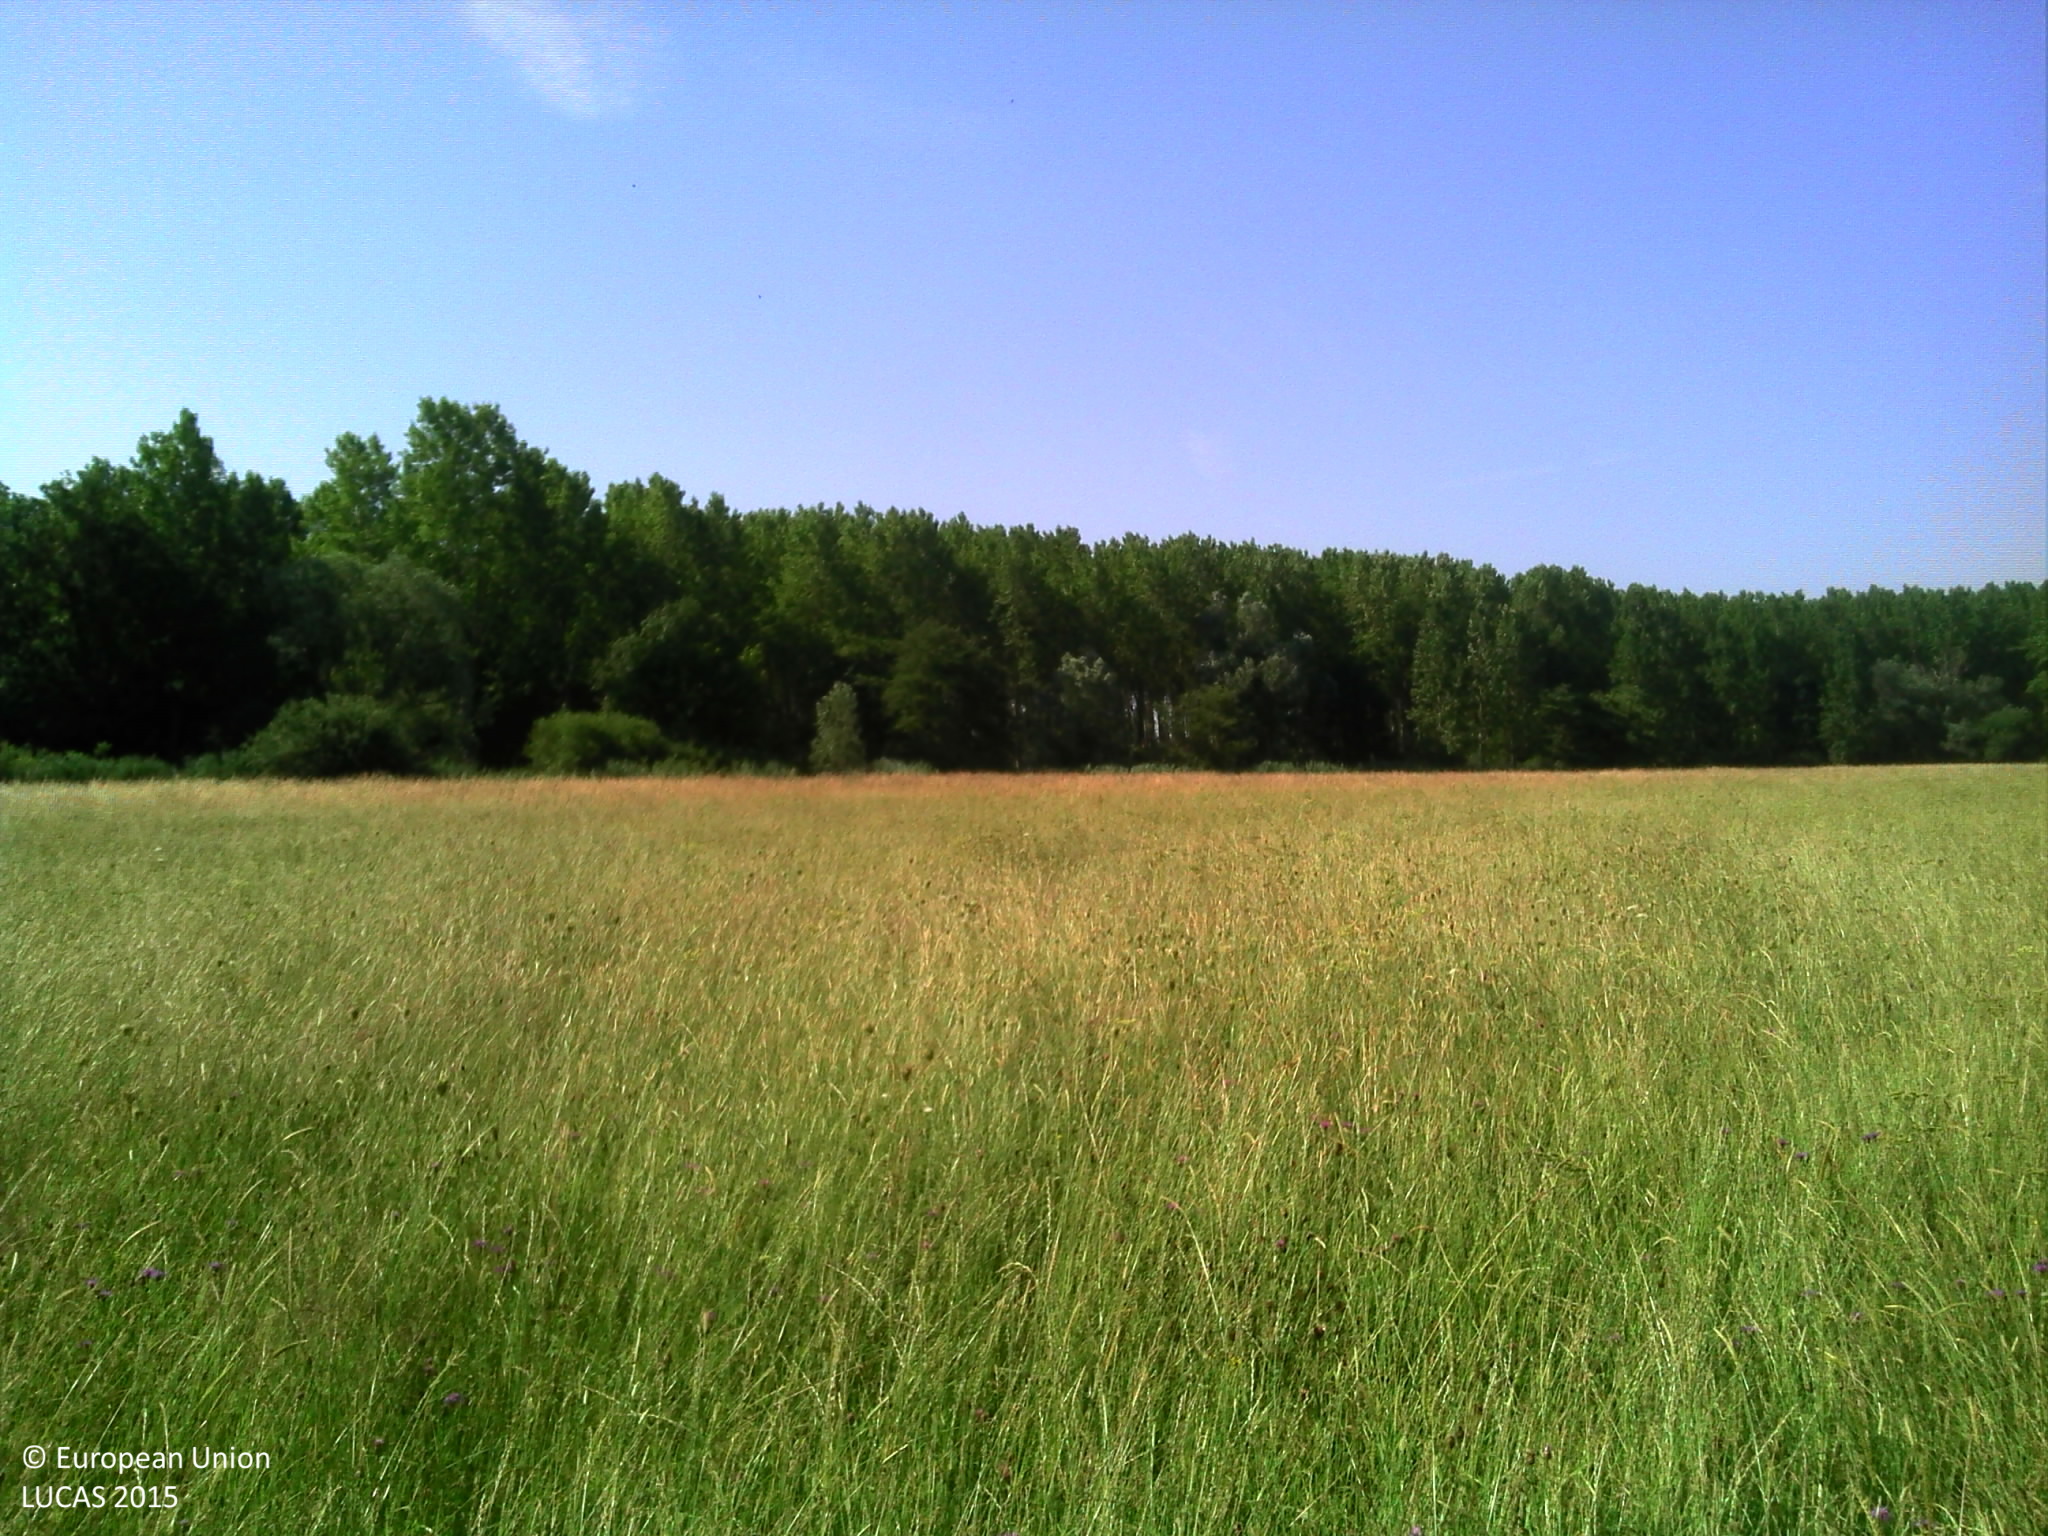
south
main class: Grassland
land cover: Grassland without tree/shrub cover
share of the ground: > 75 %
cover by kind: herbaceous plants 100 %
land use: Agriculture (excluding fallow land and kitchen gardens)
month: June
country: FR
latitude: 46.7352
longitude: 5.3039
